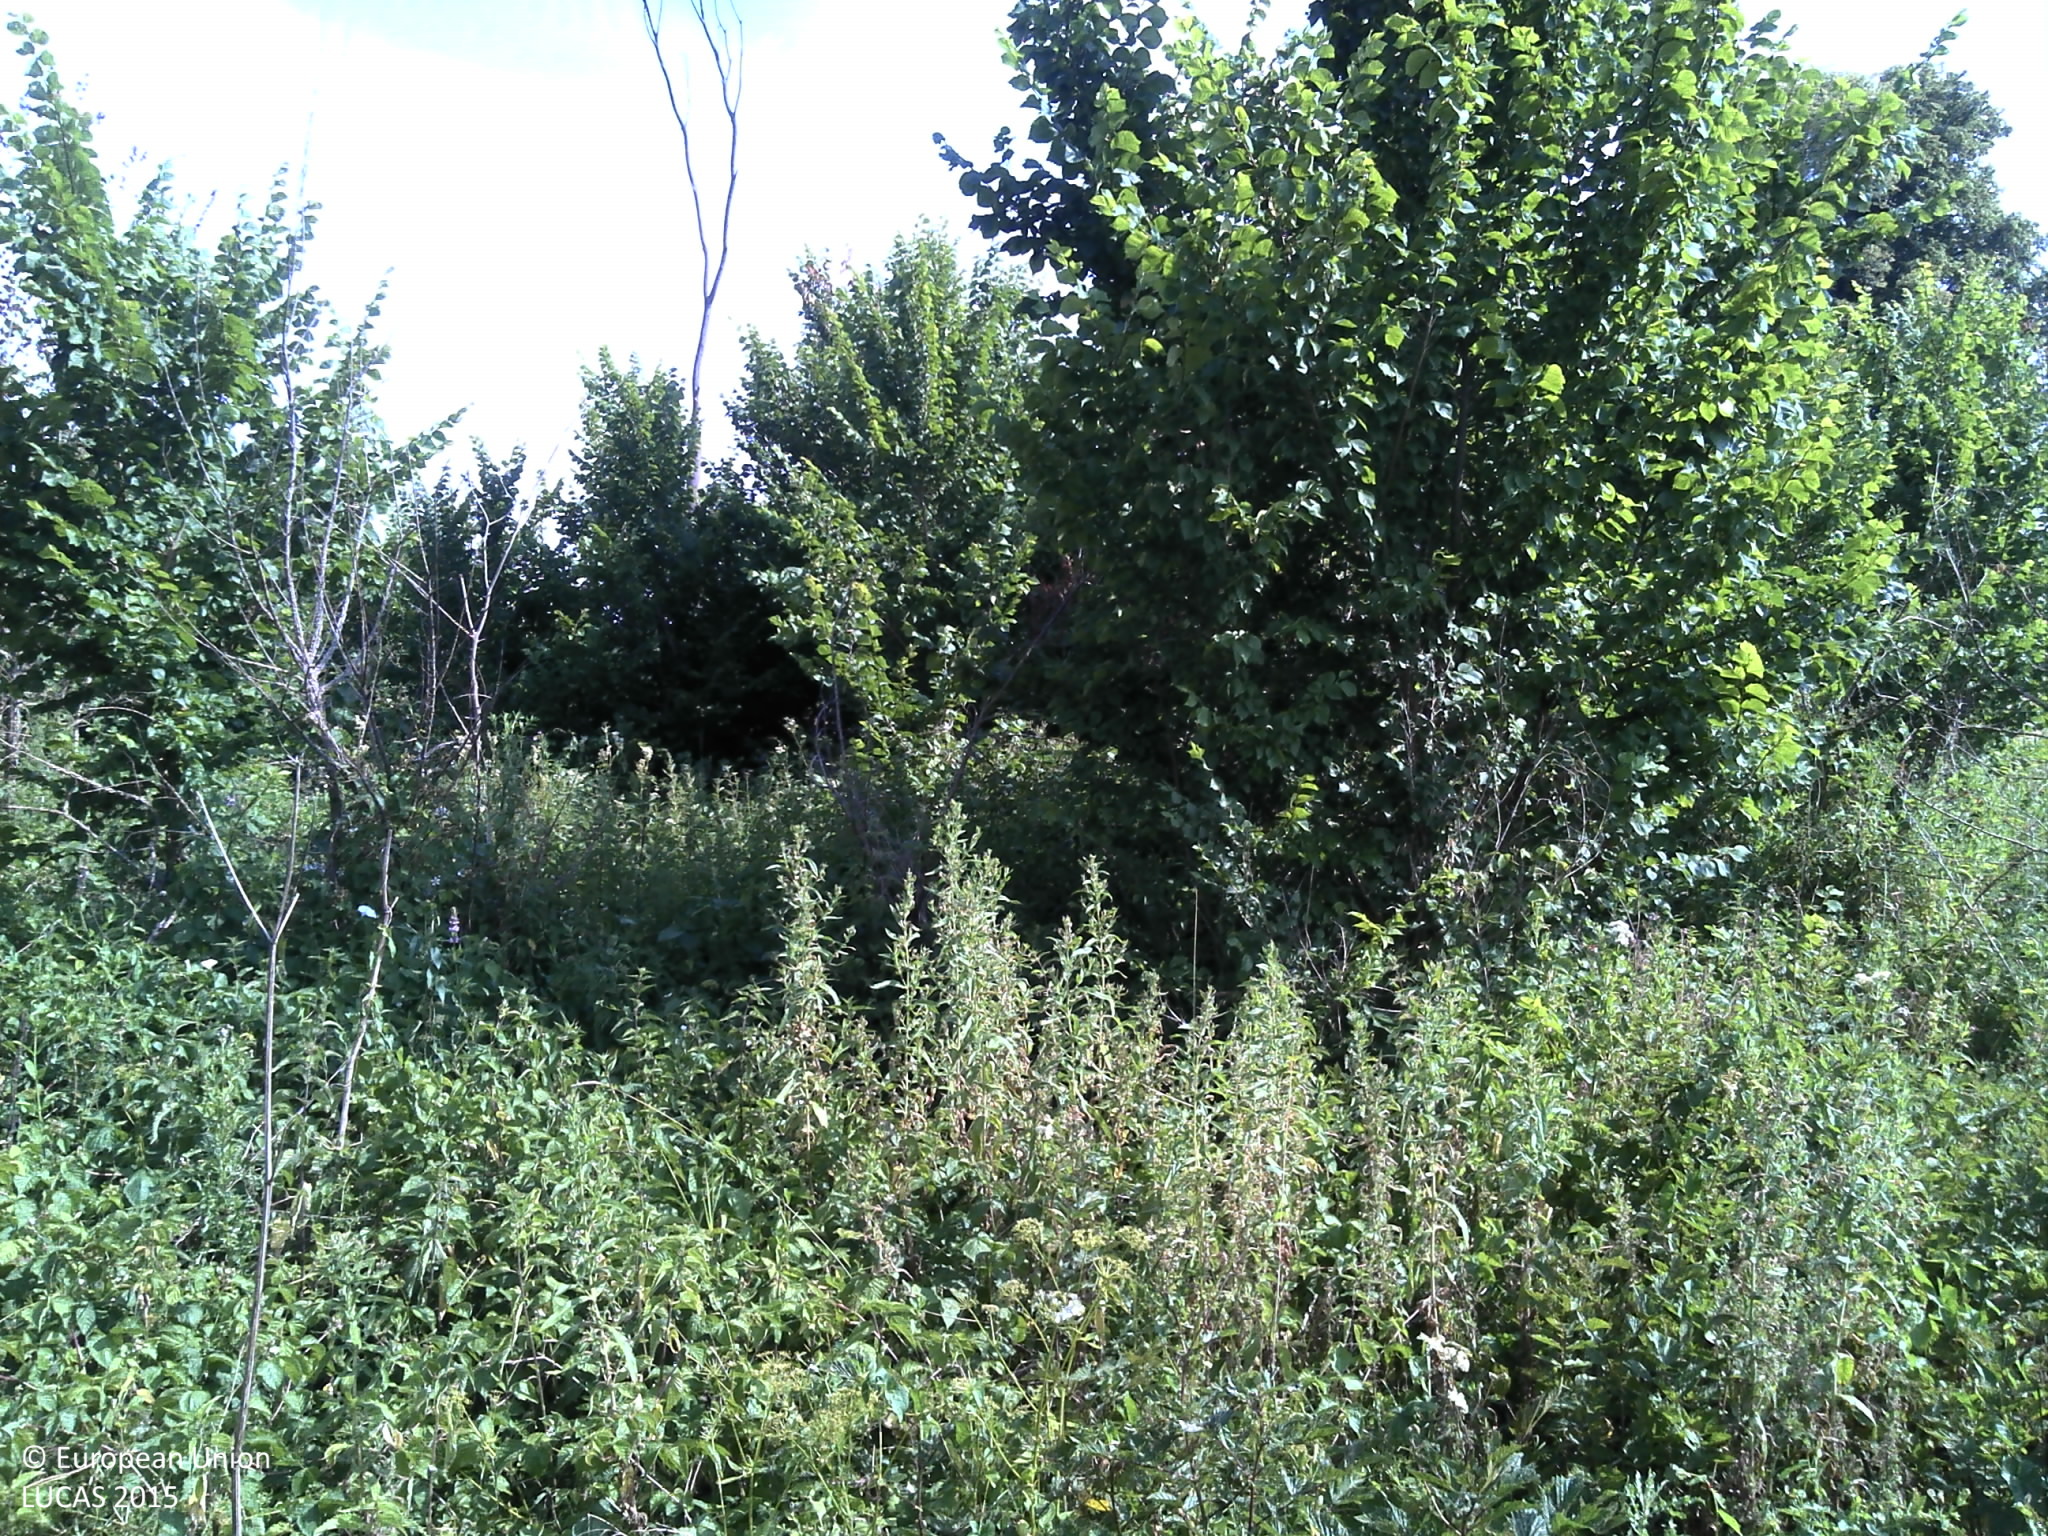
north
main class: Grassland
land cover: Spontaneously vegetated surfaces
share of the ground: > 75 %
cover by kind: herbaceous plants 100 %
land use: Abandoned areas
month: July
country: FR
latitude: 49.7192
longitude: 4.7122
